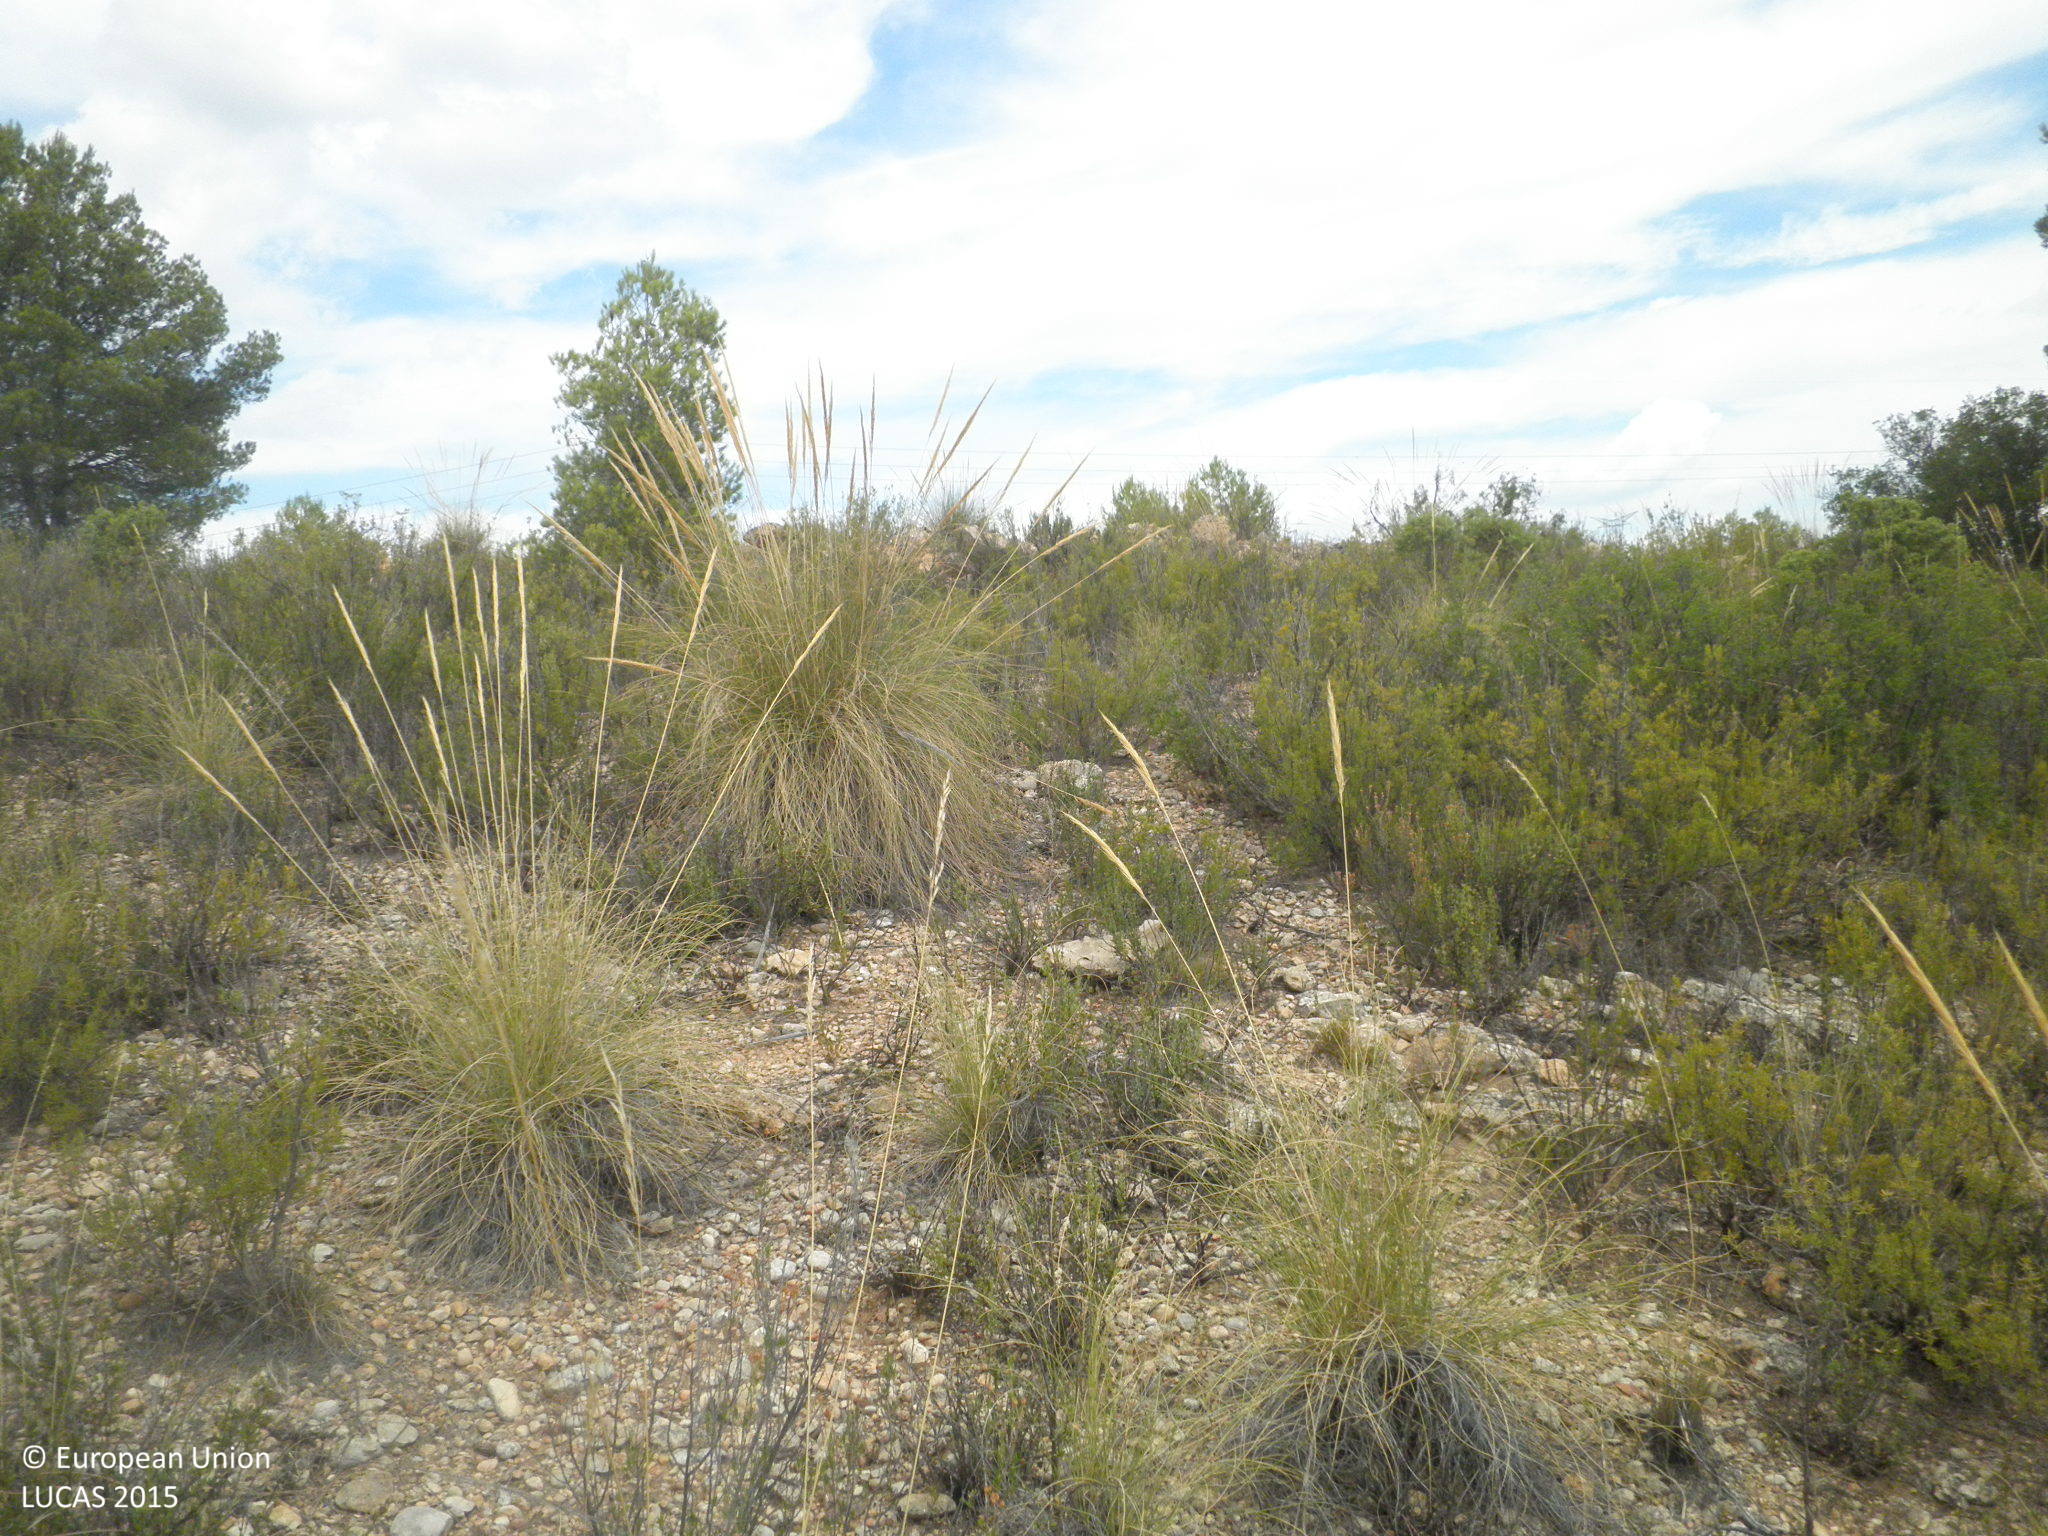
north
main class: Woodland
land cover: Pine dominated coniferous woodland
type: coniferous forest of the mediterranean region
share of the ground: 10 - 25 %
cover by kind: unconsolidated bare surface 45 %, shrubs 40 %, coniferous forest trees 10 %, herbaceous plants 5 %
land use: Semi-natural and natural areas not in use
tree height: < 5 m
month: July
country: ES
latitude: 39.5299
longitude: -1.5338
